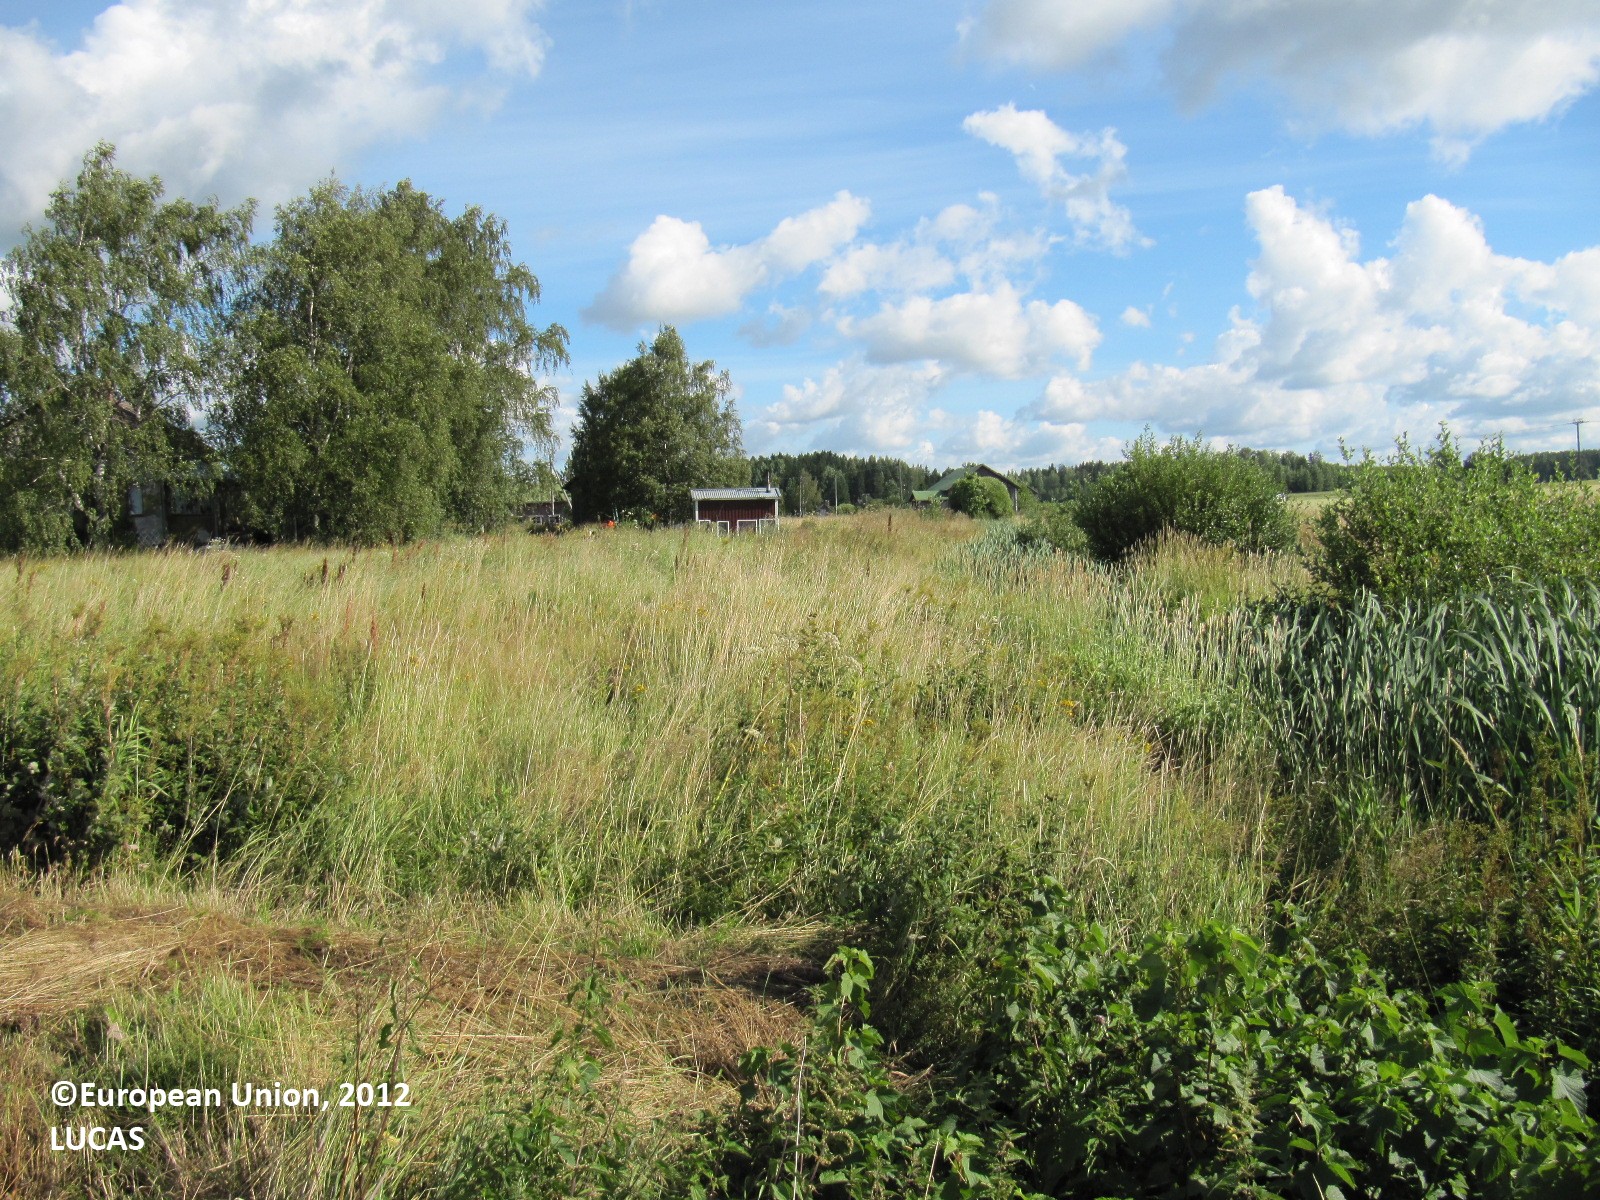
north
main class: Grassland
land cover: Spontaneously vegetated surfaces
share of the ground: > 75 %
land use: Fallow land
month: August
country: FI
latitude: 60.4751
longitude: 23.1606
